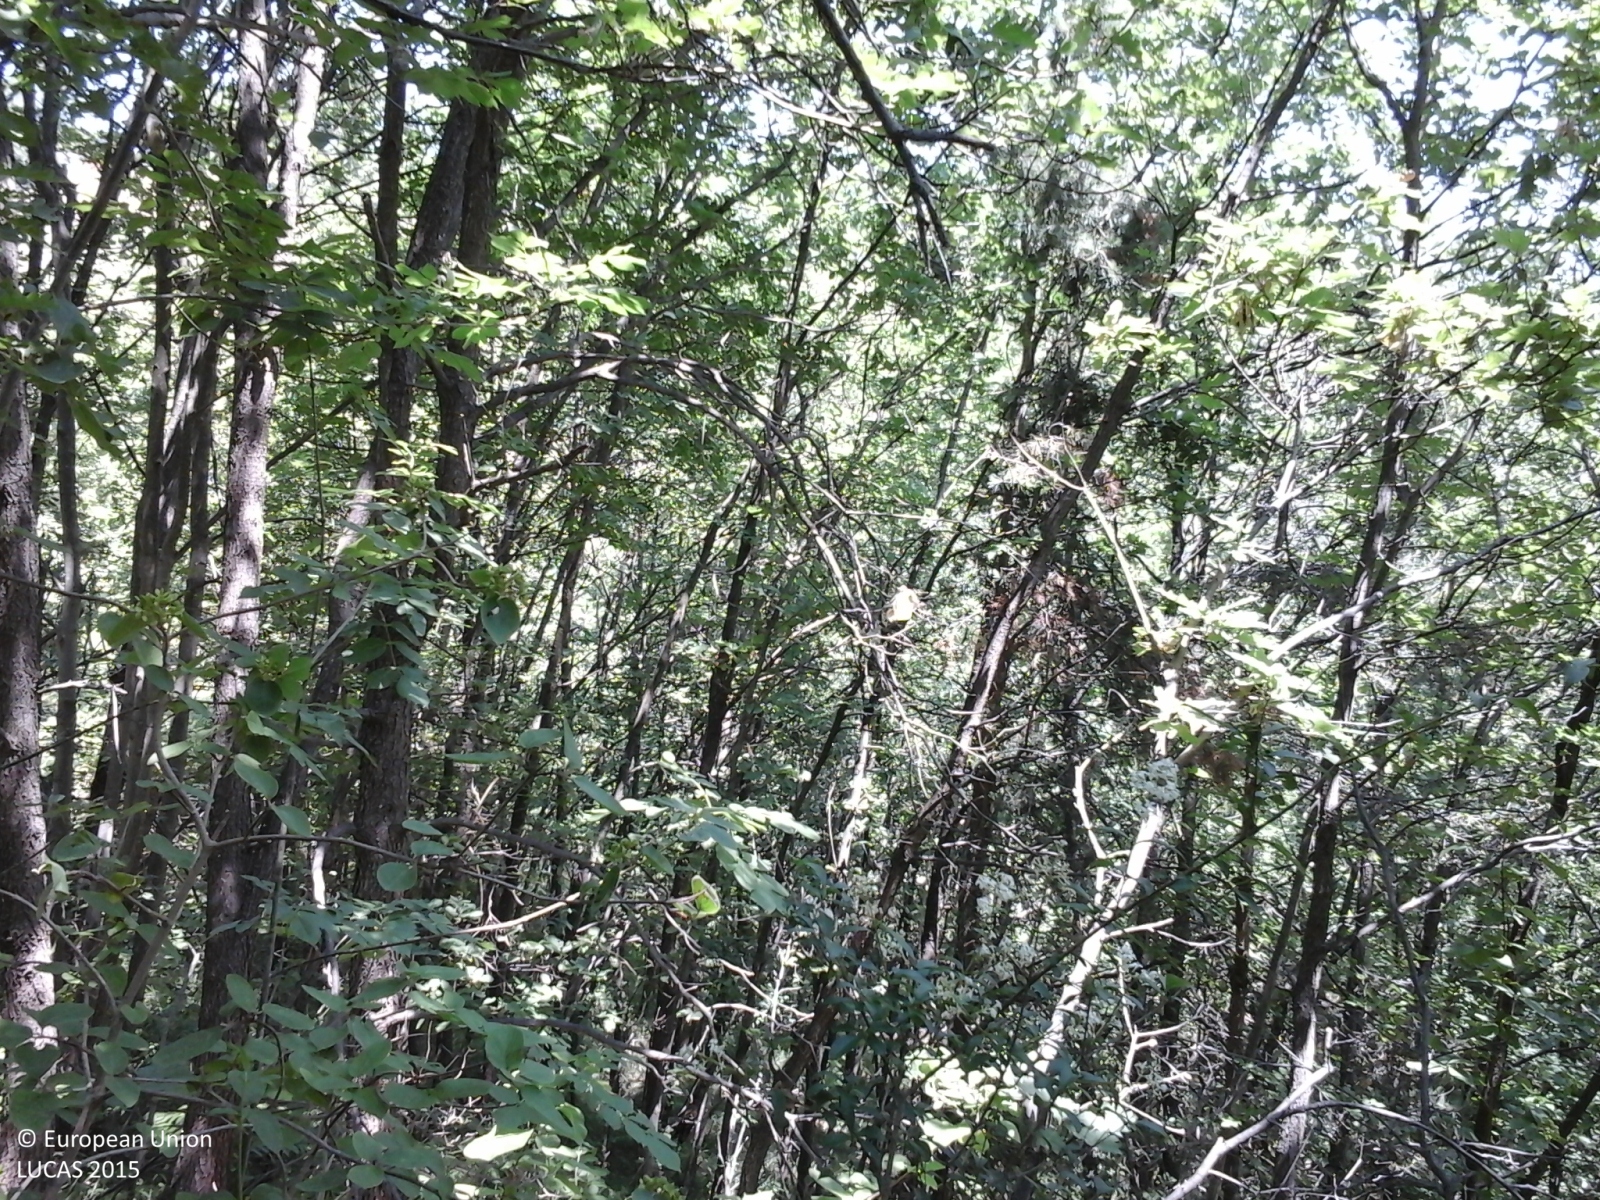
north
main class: Woodland
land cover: Broadleaved woodland
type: mesophytic deciduous forest
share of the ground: > 75 %
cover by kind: broadleaved forest trees 90 %, shrubs 5 %, herbaceous plants 5 %
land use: Forestry
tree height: > 5 m
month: June
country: IT
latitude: 44.6605
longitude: 8.2506
